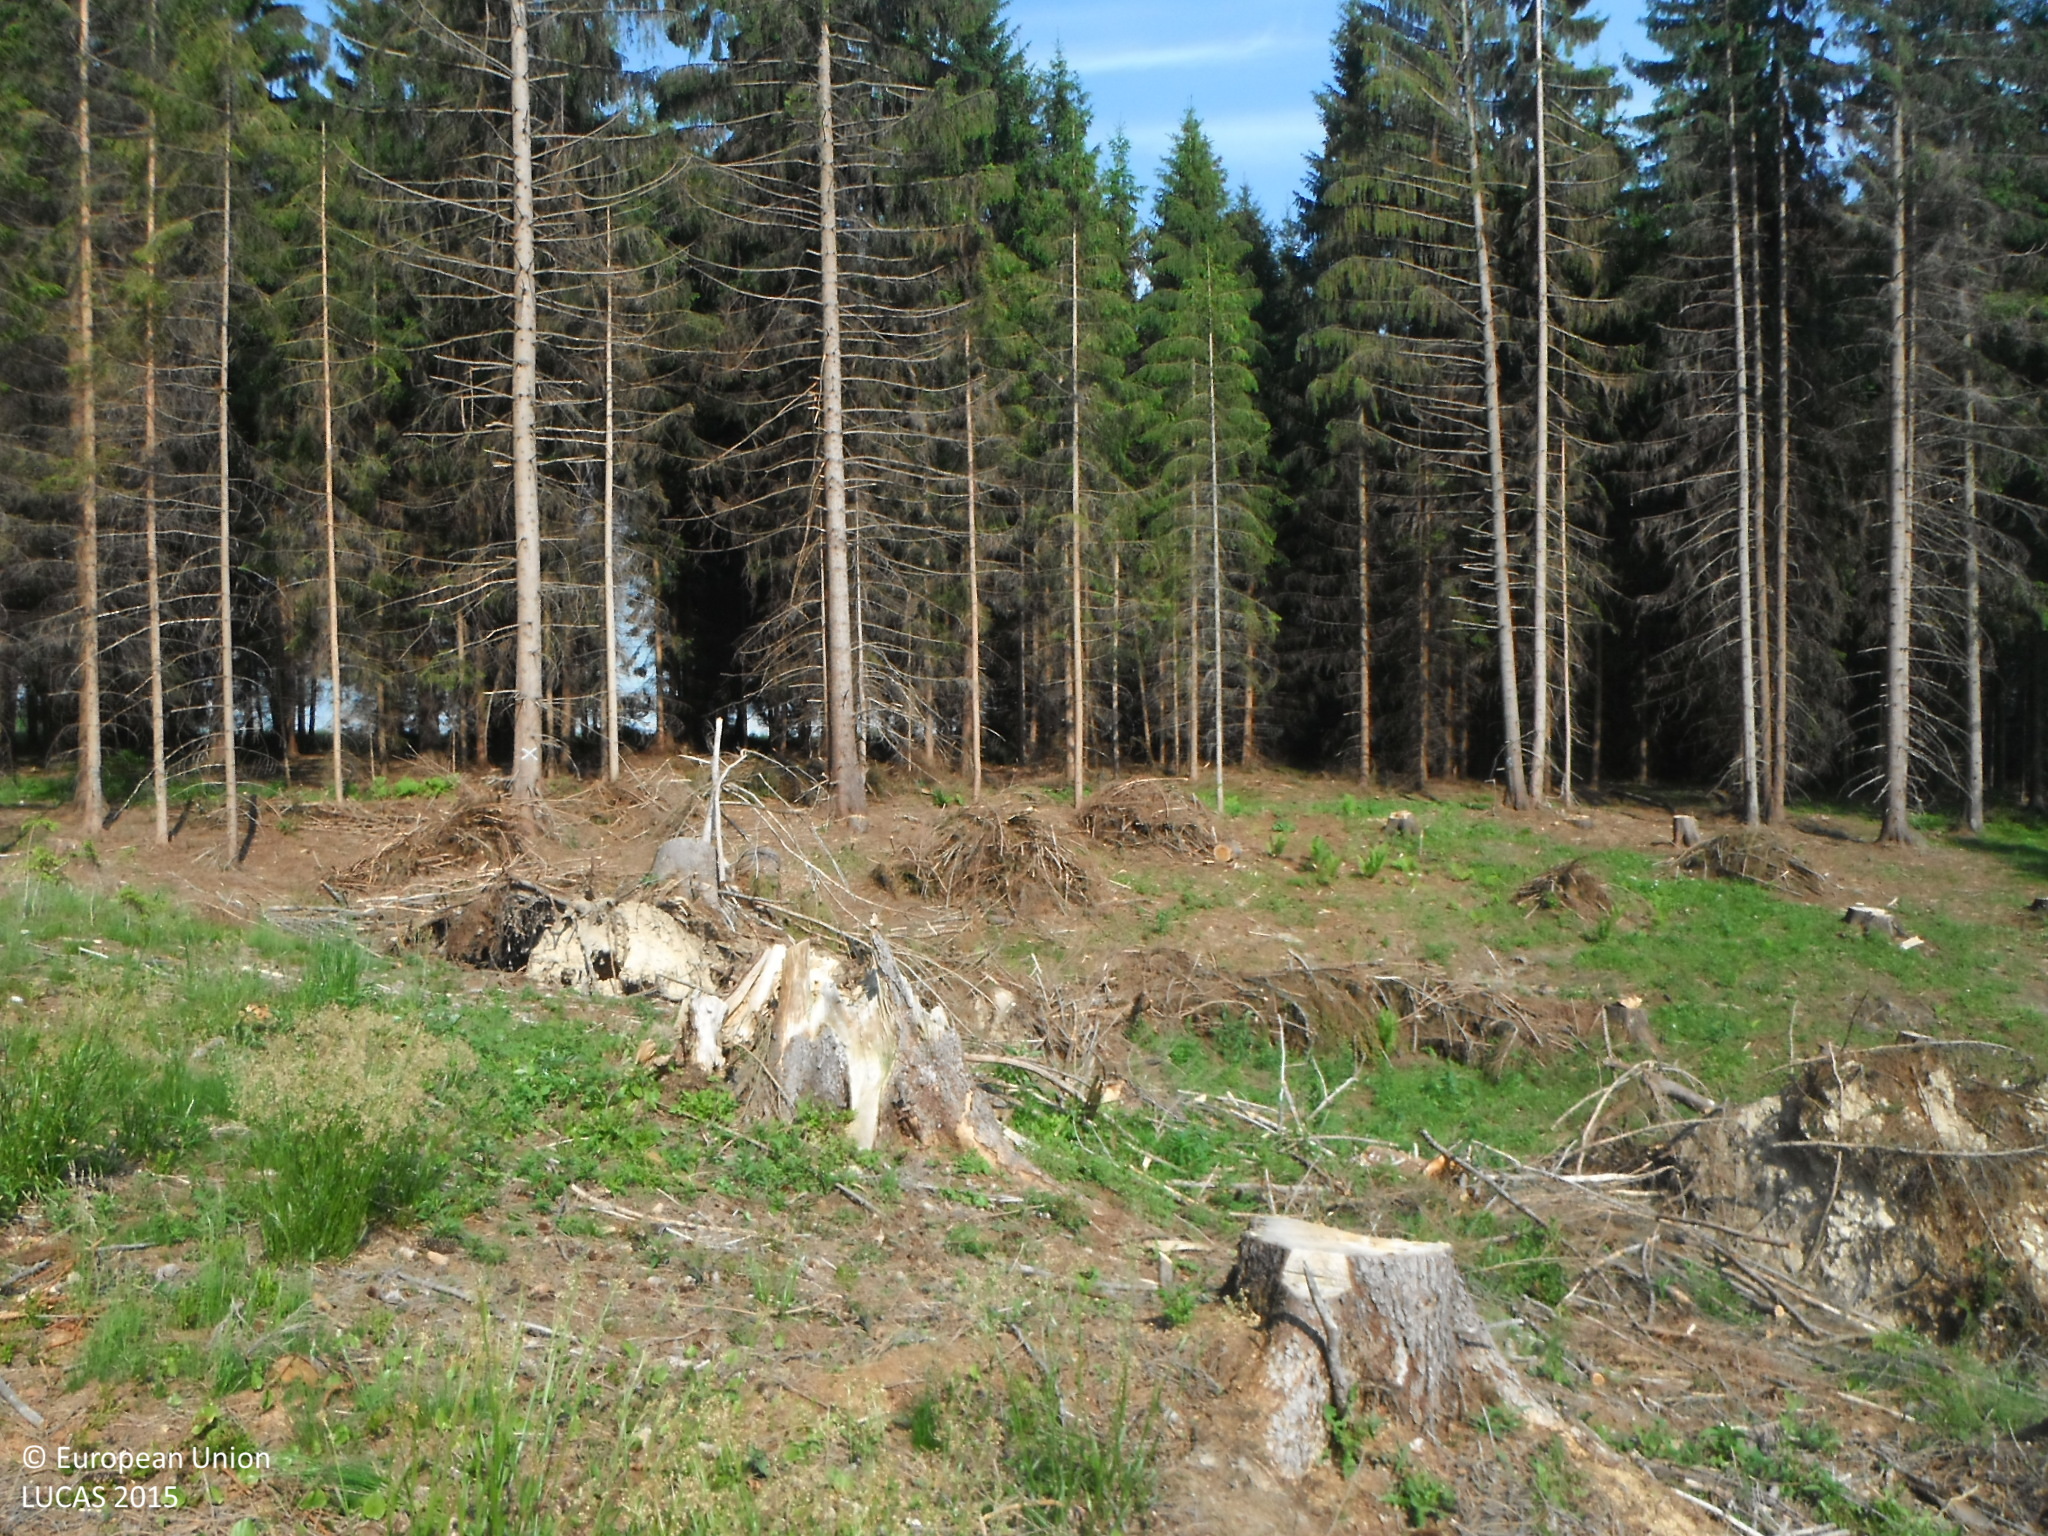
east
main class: Grassland
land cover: Spontaneously vegetated surfaces
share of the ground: > 75 %
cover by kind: herbaceous plants 75 %, unconsolidated bare surface 25 %
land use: Forestry
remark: Clear cut
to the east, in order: Spontaneously vegetated surfaces; Spruce dominated coniferous woodland; Grassland without tree/shrub cover
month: June
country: SK
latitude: 49.0712
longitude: 19.8162
